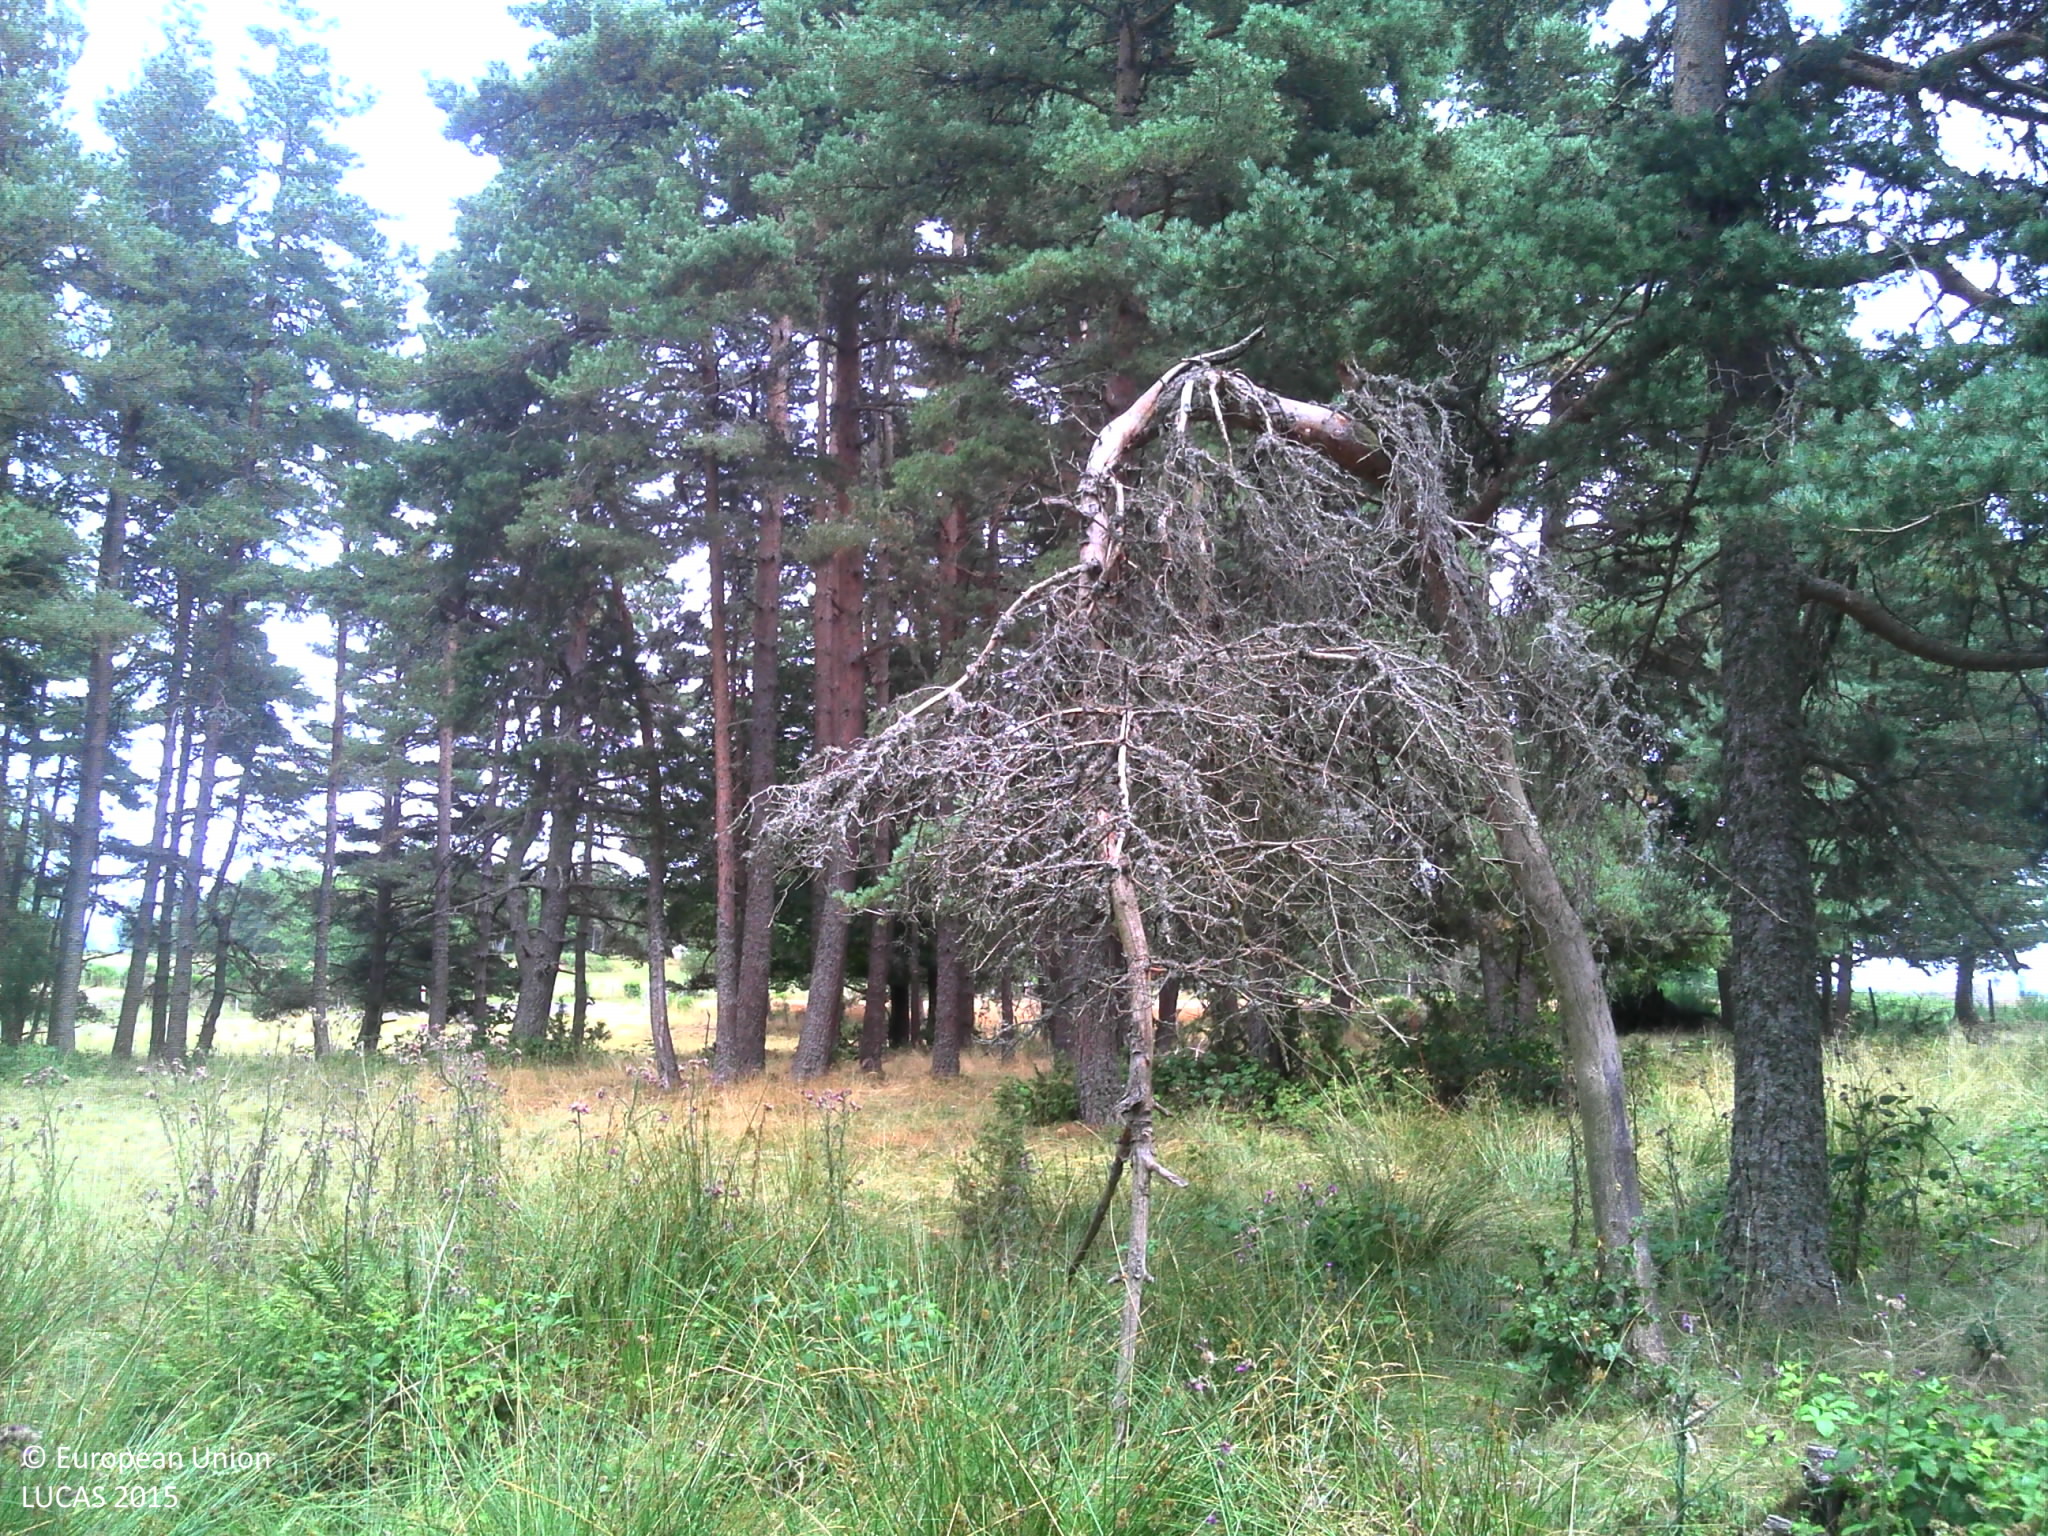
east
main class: Woodland
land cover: Pine dominated coniferous woodland
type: alpine coniferous forest
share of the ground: > 75 %
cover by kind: coniferous forest trees 75 %, broadleaved forest trees 25 %
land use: Forestry
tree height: > 5 m
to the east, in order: Pine dominated coniferous woodland; Fences; Common wheat; Fences; Ditches and canals; Paved roads, cycling and walking lanes; Grassland without tree/shrub cover; Electric lines; Paved roads, cycling and walking lanes; Ditches and canals; Fences; Grassland without tree/shrub cover; Fences; Tracks; Ditches and canals; Fences; Pine dominated coniferous woodland
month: July
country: FR
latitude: 44.8516
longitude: 3.2085
